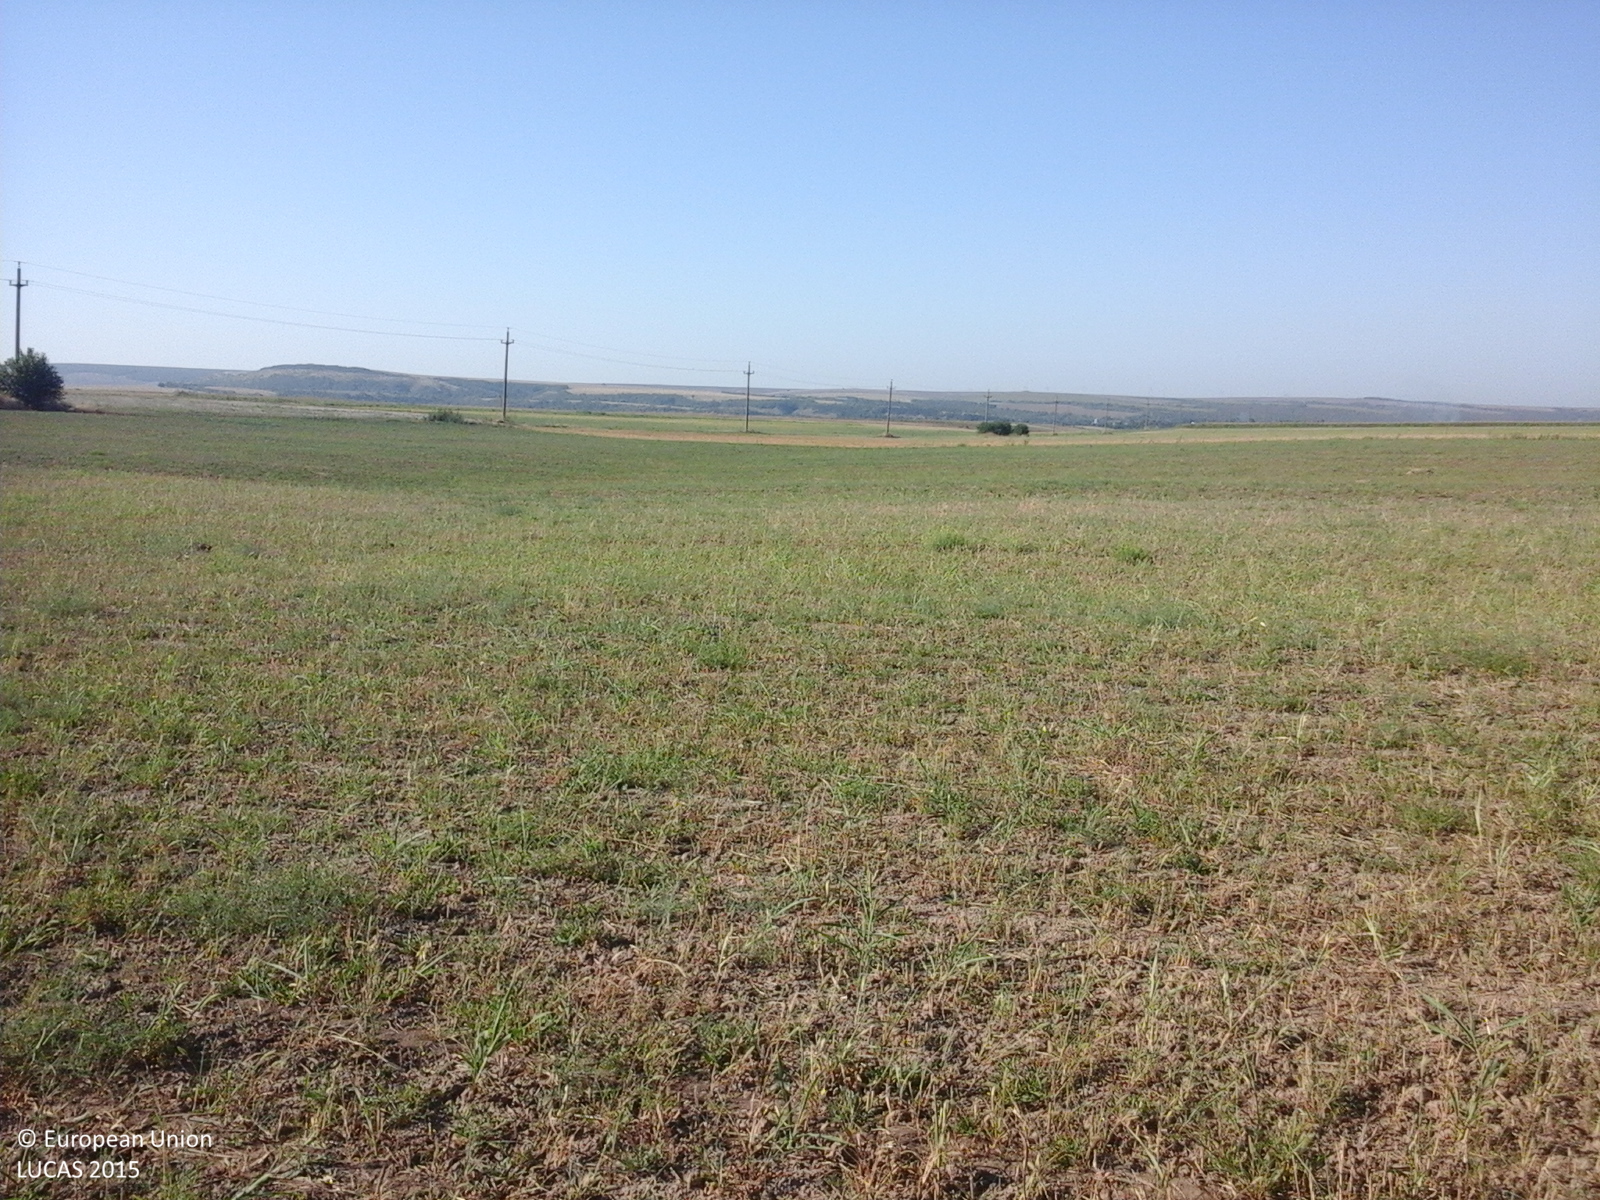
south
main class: Cropland
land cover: Maize
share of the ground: > 75 %
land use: Agriculture (excluding fallow land and kitchen gardens)
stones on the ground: < 10 %
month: August
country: RO
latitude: 44.6246
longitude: 28.0976
